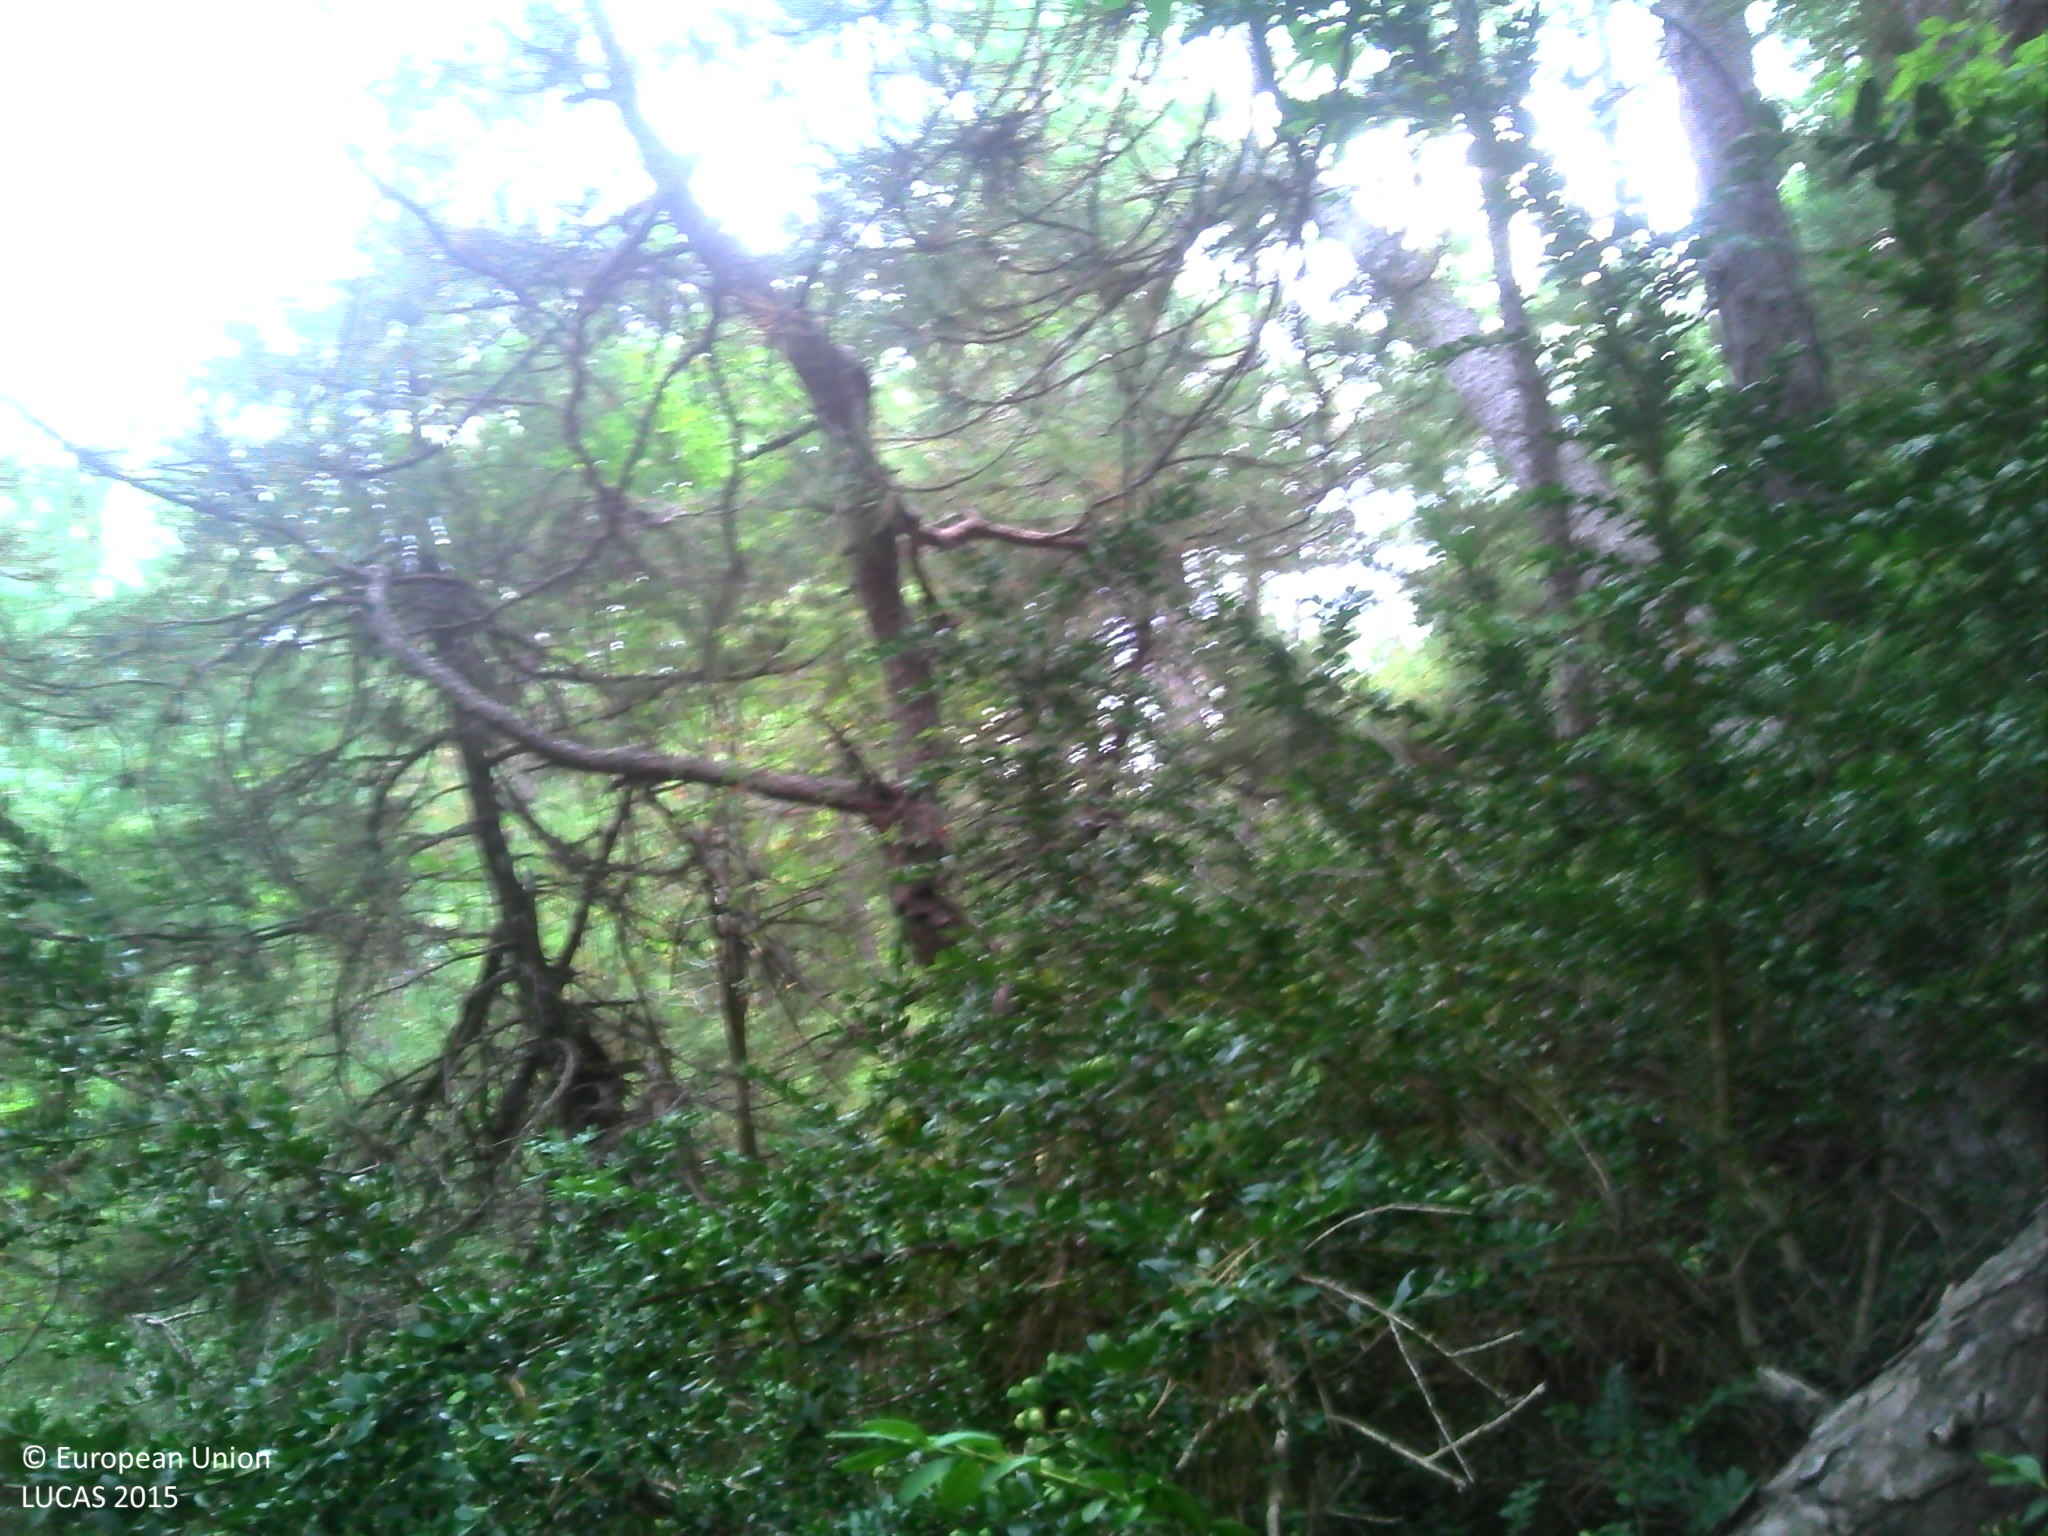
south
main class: Woodland
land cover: Pine dominated coniferous woodland
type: coniferous forest of the mediterranean region
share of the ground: > 75 %
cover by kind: coniferous forest trees 85 %, shrubs 10 %, broadleaved forest trees 5 %
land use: Semi-natural and natural areas not in use
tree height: > 5 m
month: September
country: FR
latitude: 44.6336
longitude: 5.5316
